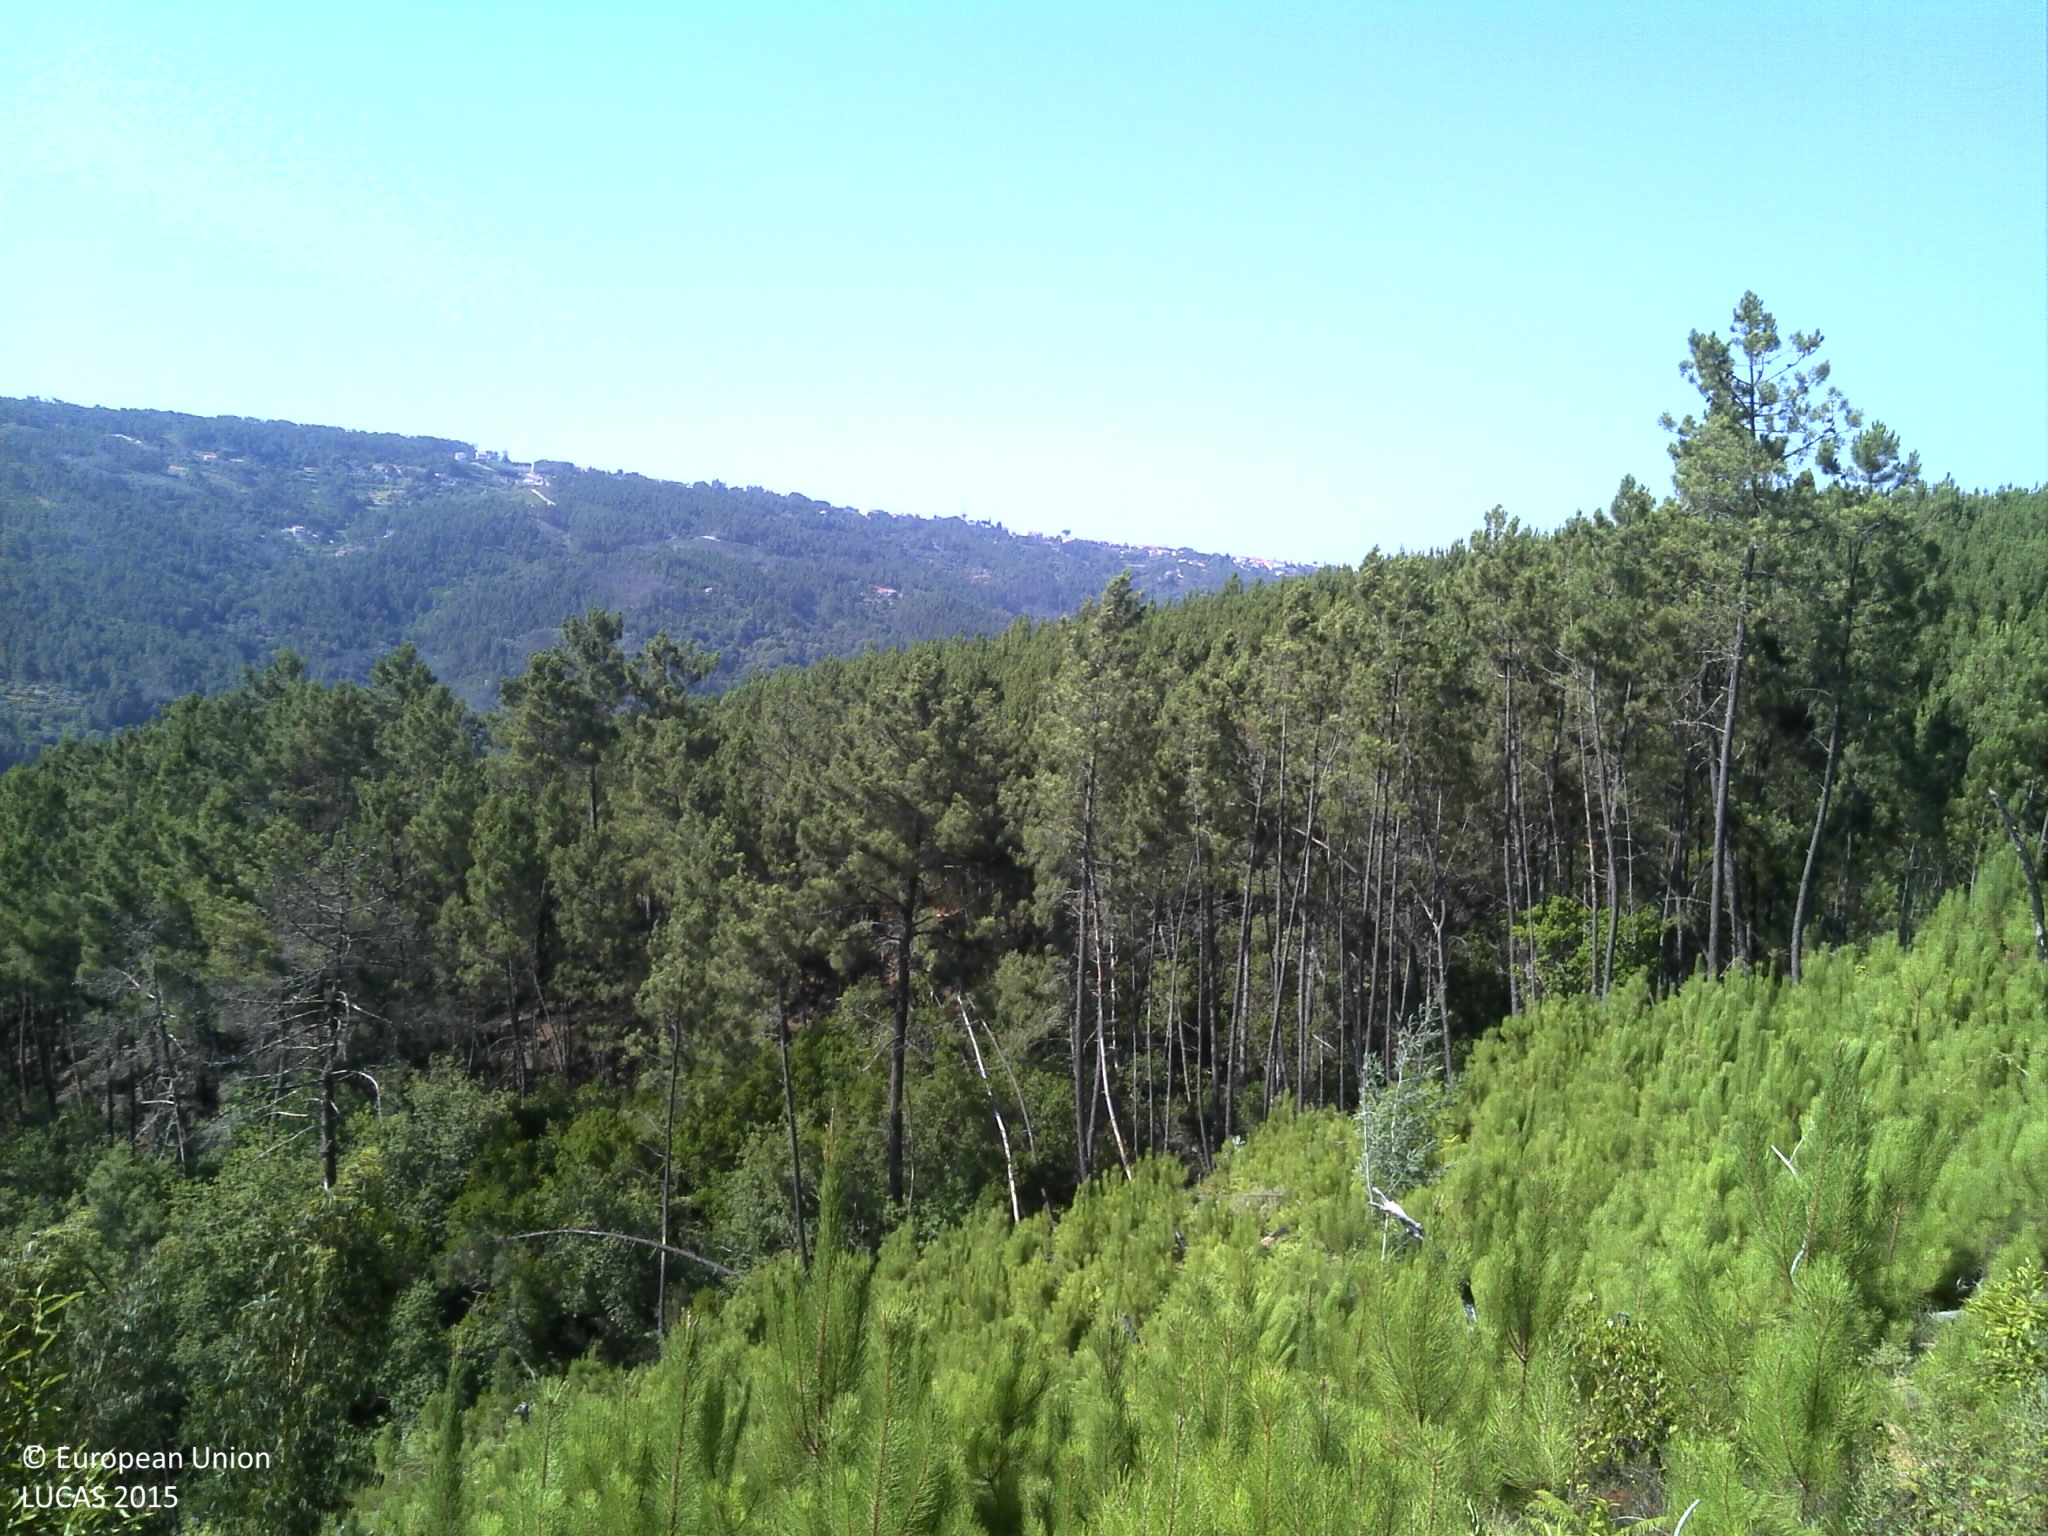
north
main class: Woodland
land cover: Pine dominated coniferous woodland
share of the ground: 50 - 75 %
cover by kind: coniferous forest trees 70 %, shrubs 30 %
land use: Forestry
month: July
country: PT
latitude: 40.3147
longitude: -7.8503
